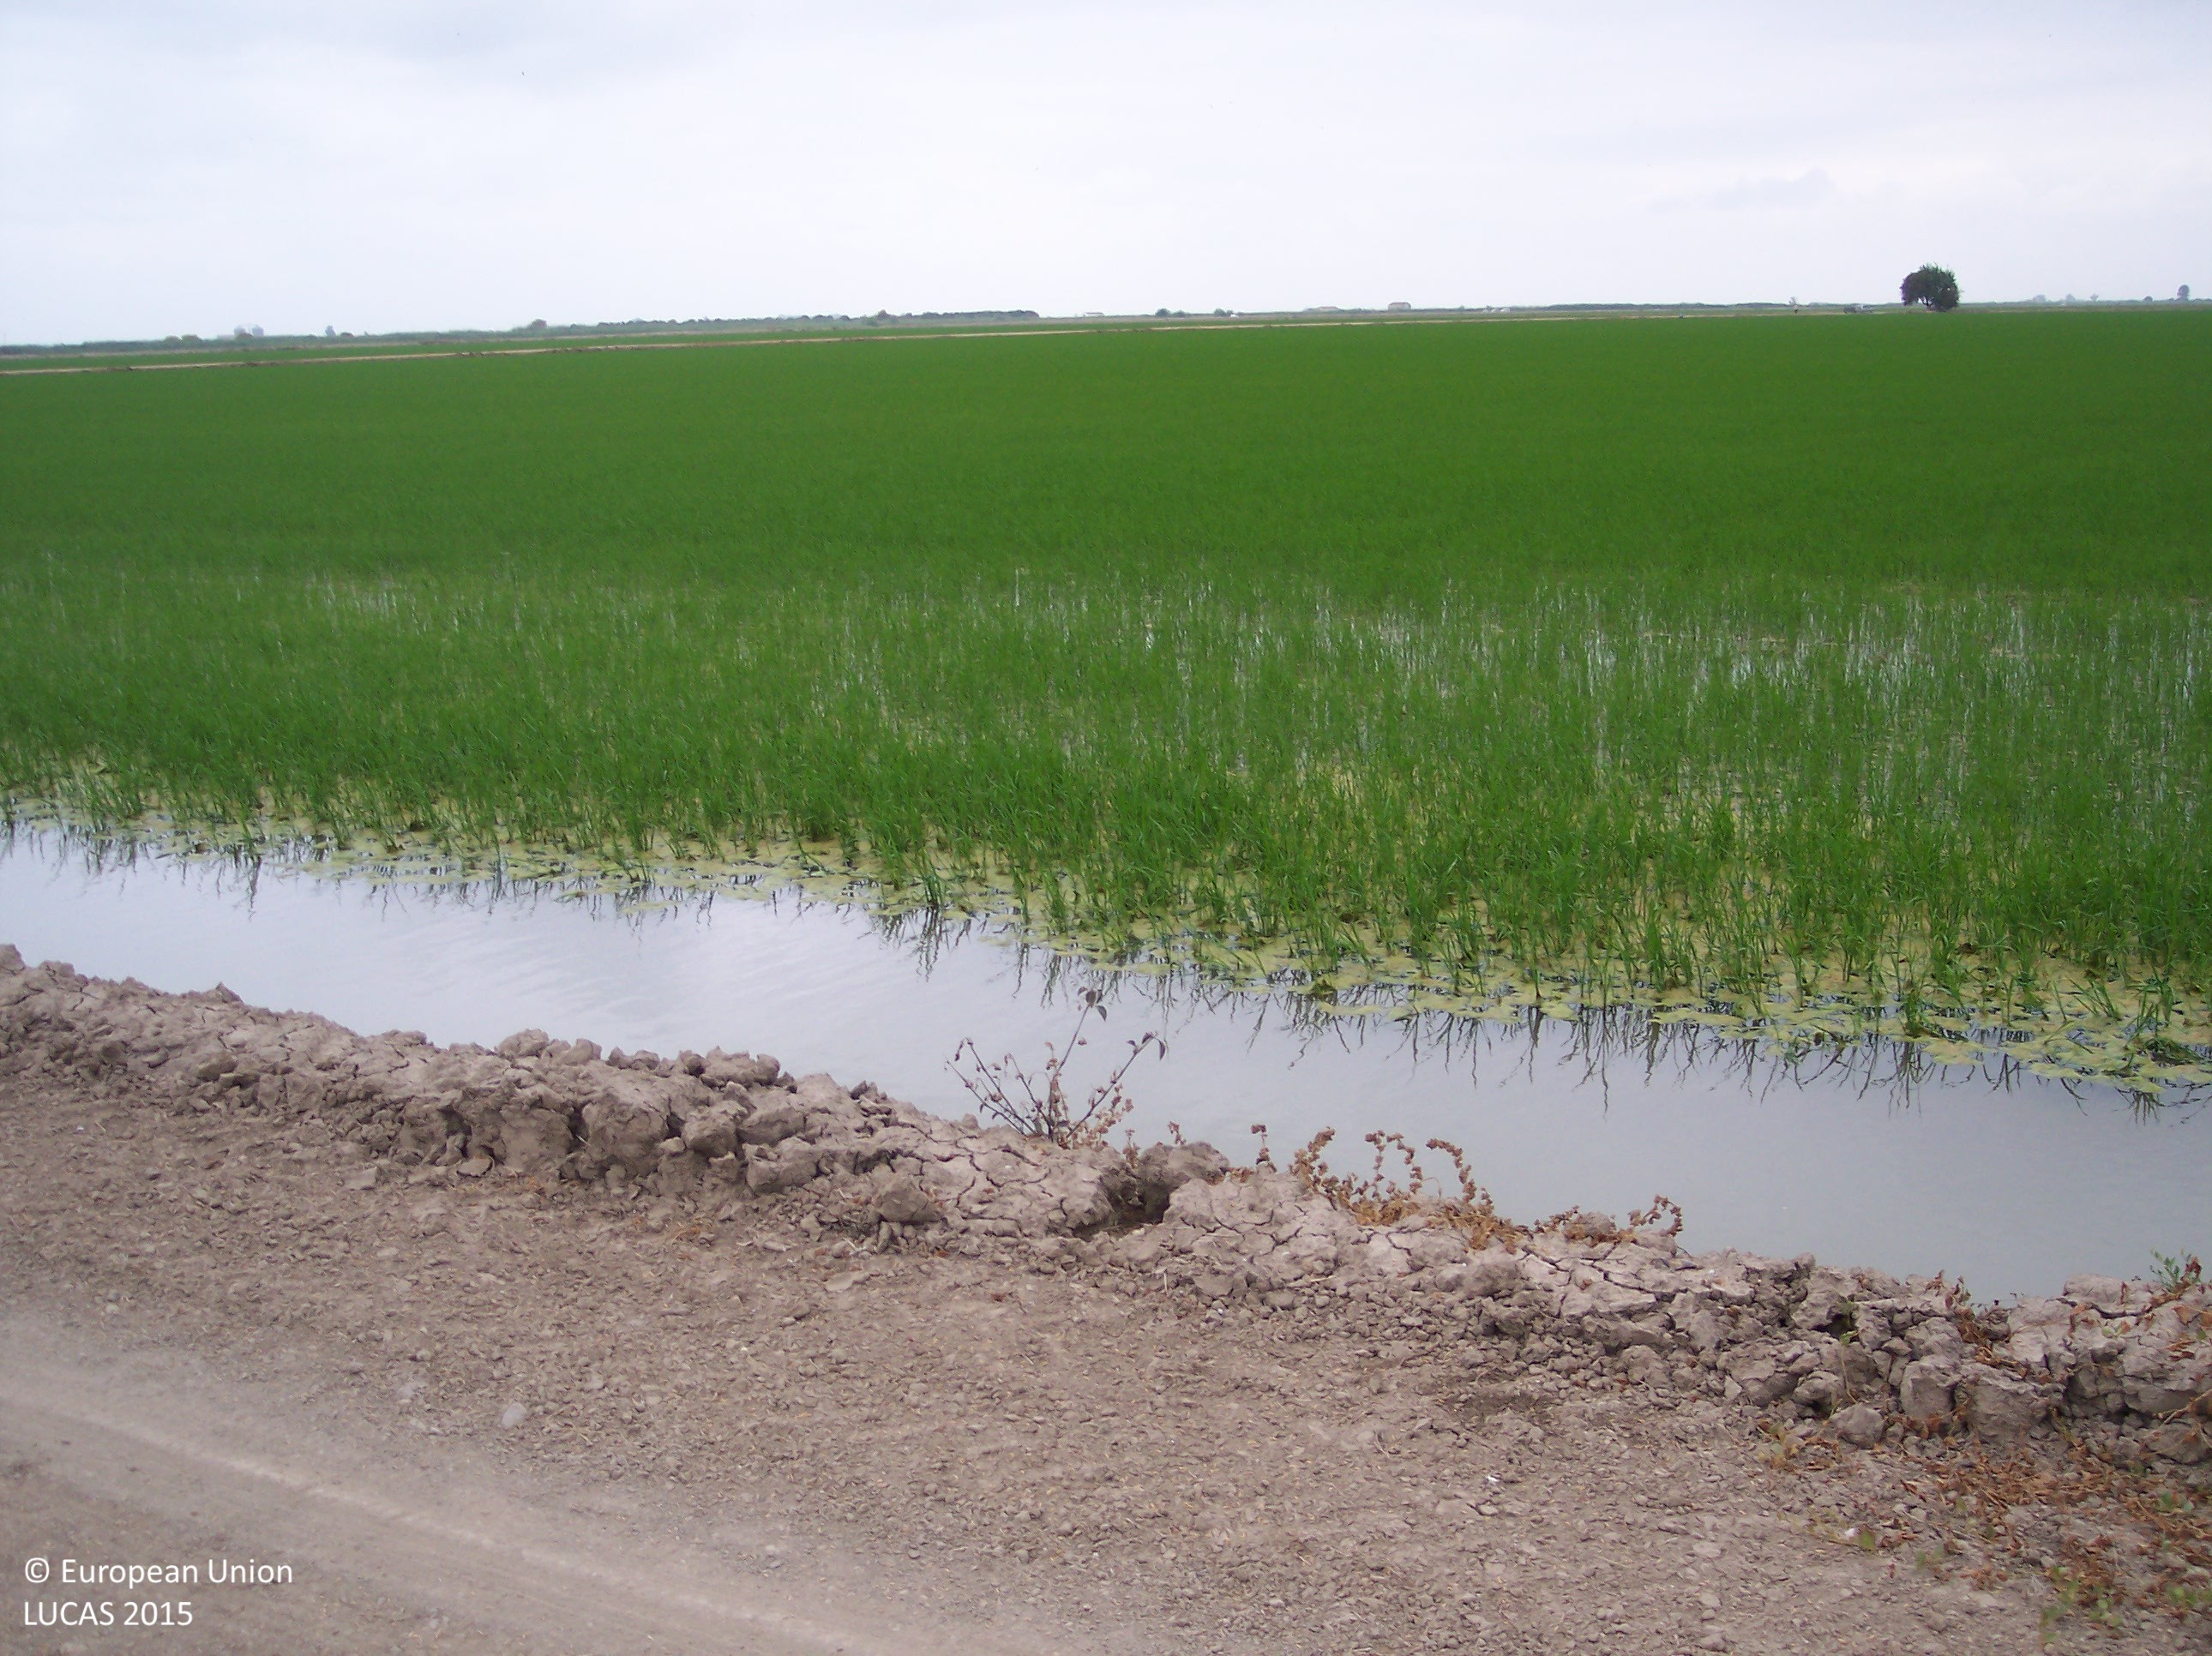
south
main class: Cropland
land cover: Rice
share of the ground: > 75 %
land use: Agriculture (excluding fallow land and kitchen gardens)
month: June
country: ES
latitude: 37.1570
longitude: -6.1120
